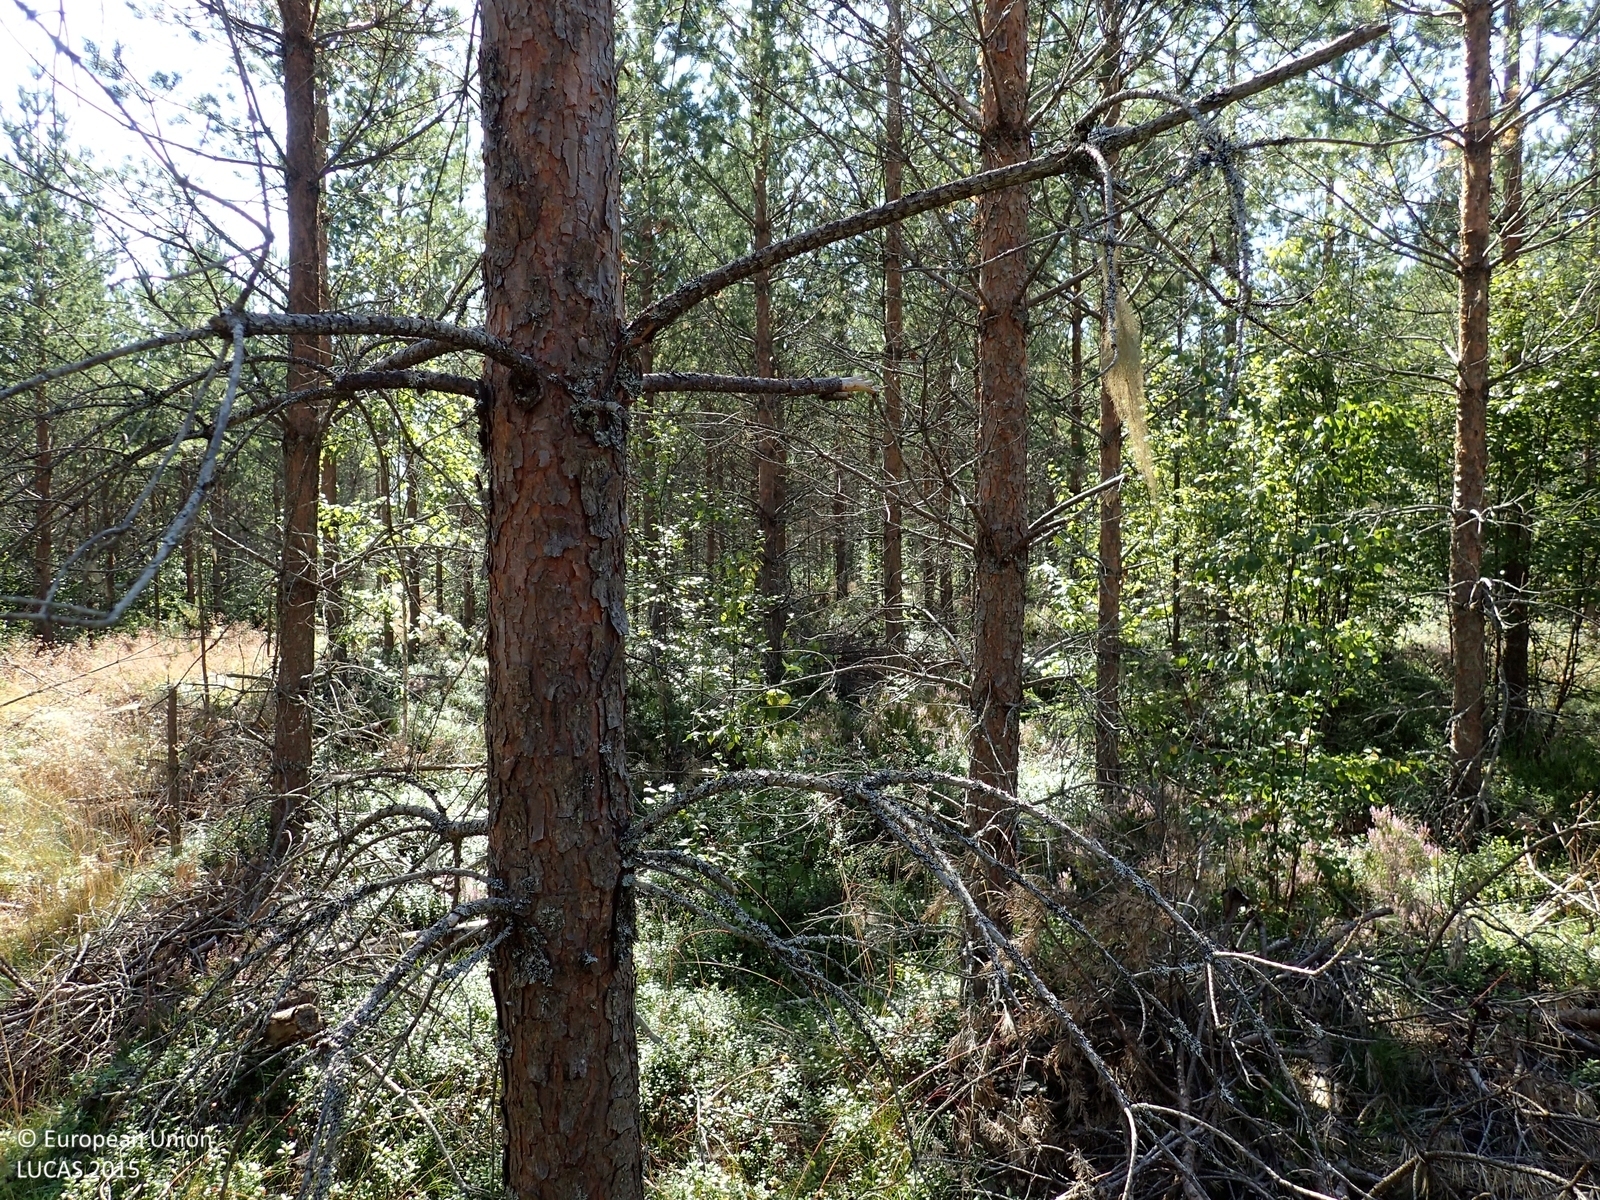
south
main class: Woodland
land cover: Pine dominated coniferous woodland
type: boreal forest
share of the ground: > 75 %
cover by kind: coniferous forest trees 75 %, shrubs 15 %, broadleaved forest trees 5 %, herbaceous plants 5 %
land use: Forestry
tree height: < 5 m
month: August
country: FI
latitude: 62.5331
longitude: 21.7648
